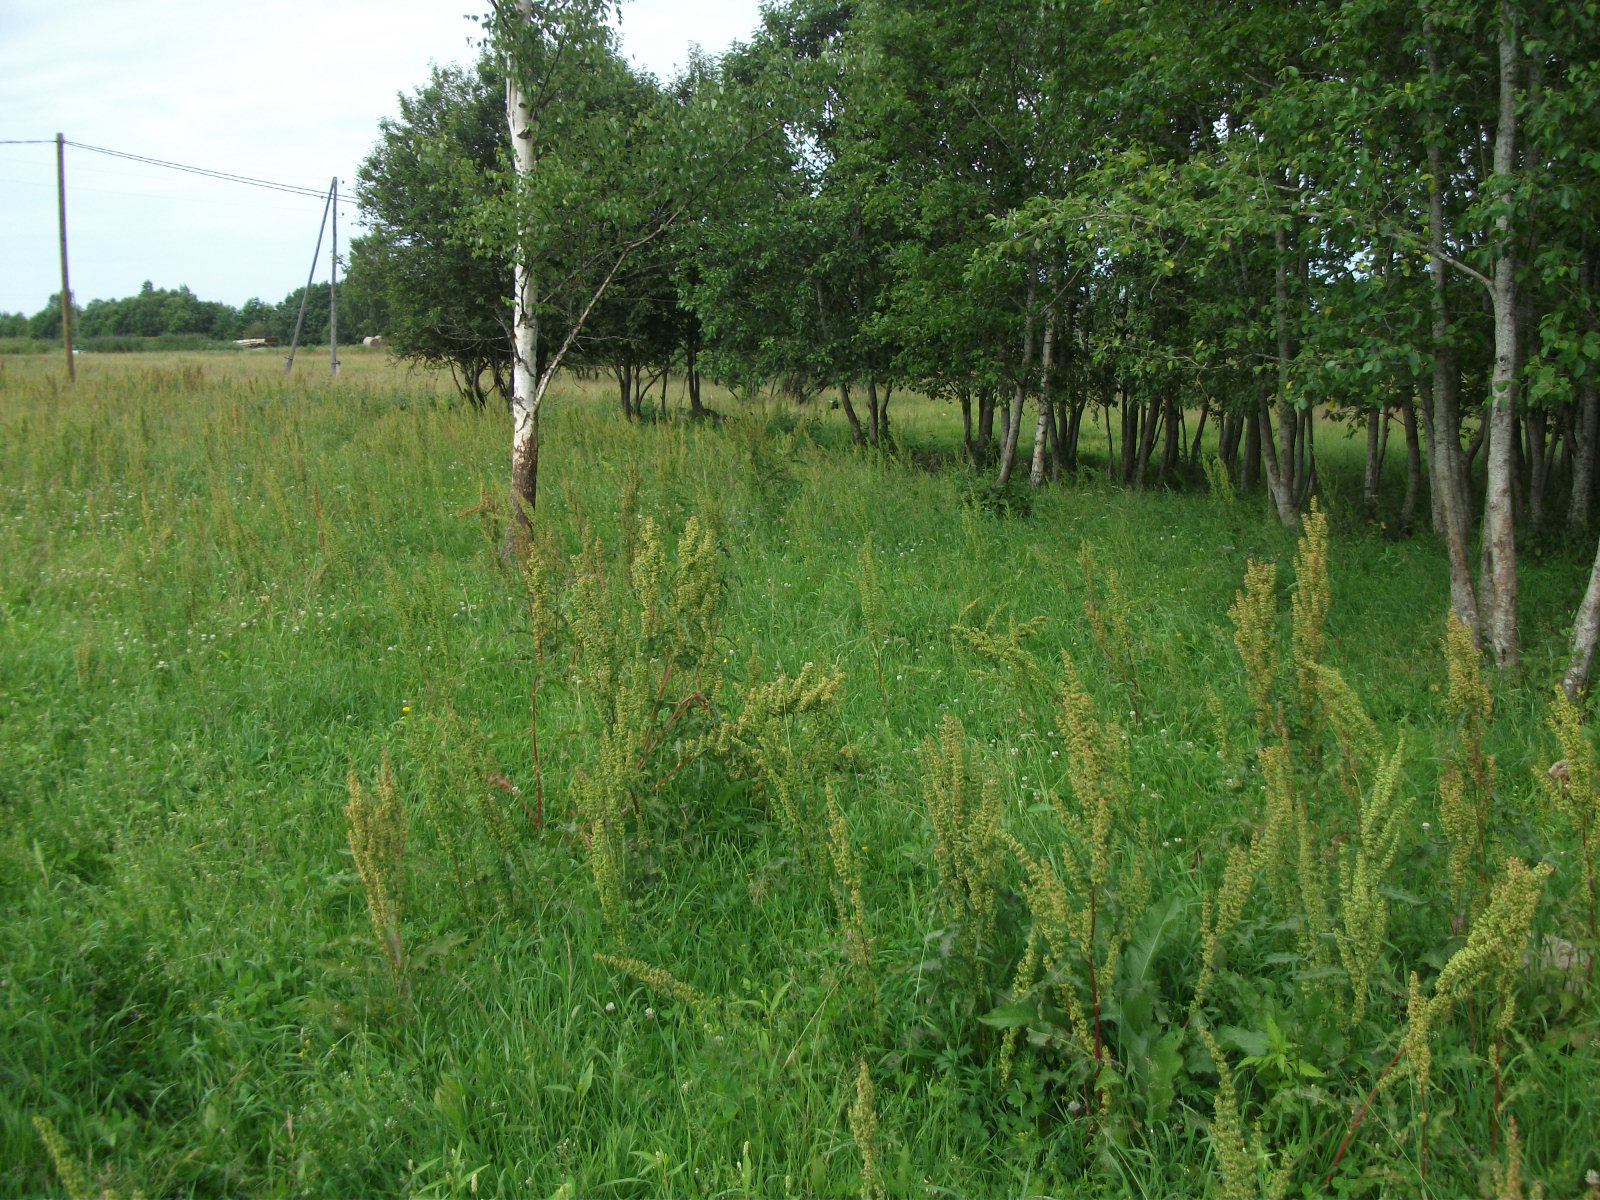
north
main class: Grassland
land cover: Grassland without tree/shrub cover
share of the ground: > 75 %
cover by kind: herbaceous plants 100 %
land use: Agriculture (excluding fallow land and kitchen gardens)
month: July
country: LV
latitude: 57.1485
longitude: 26.5251
